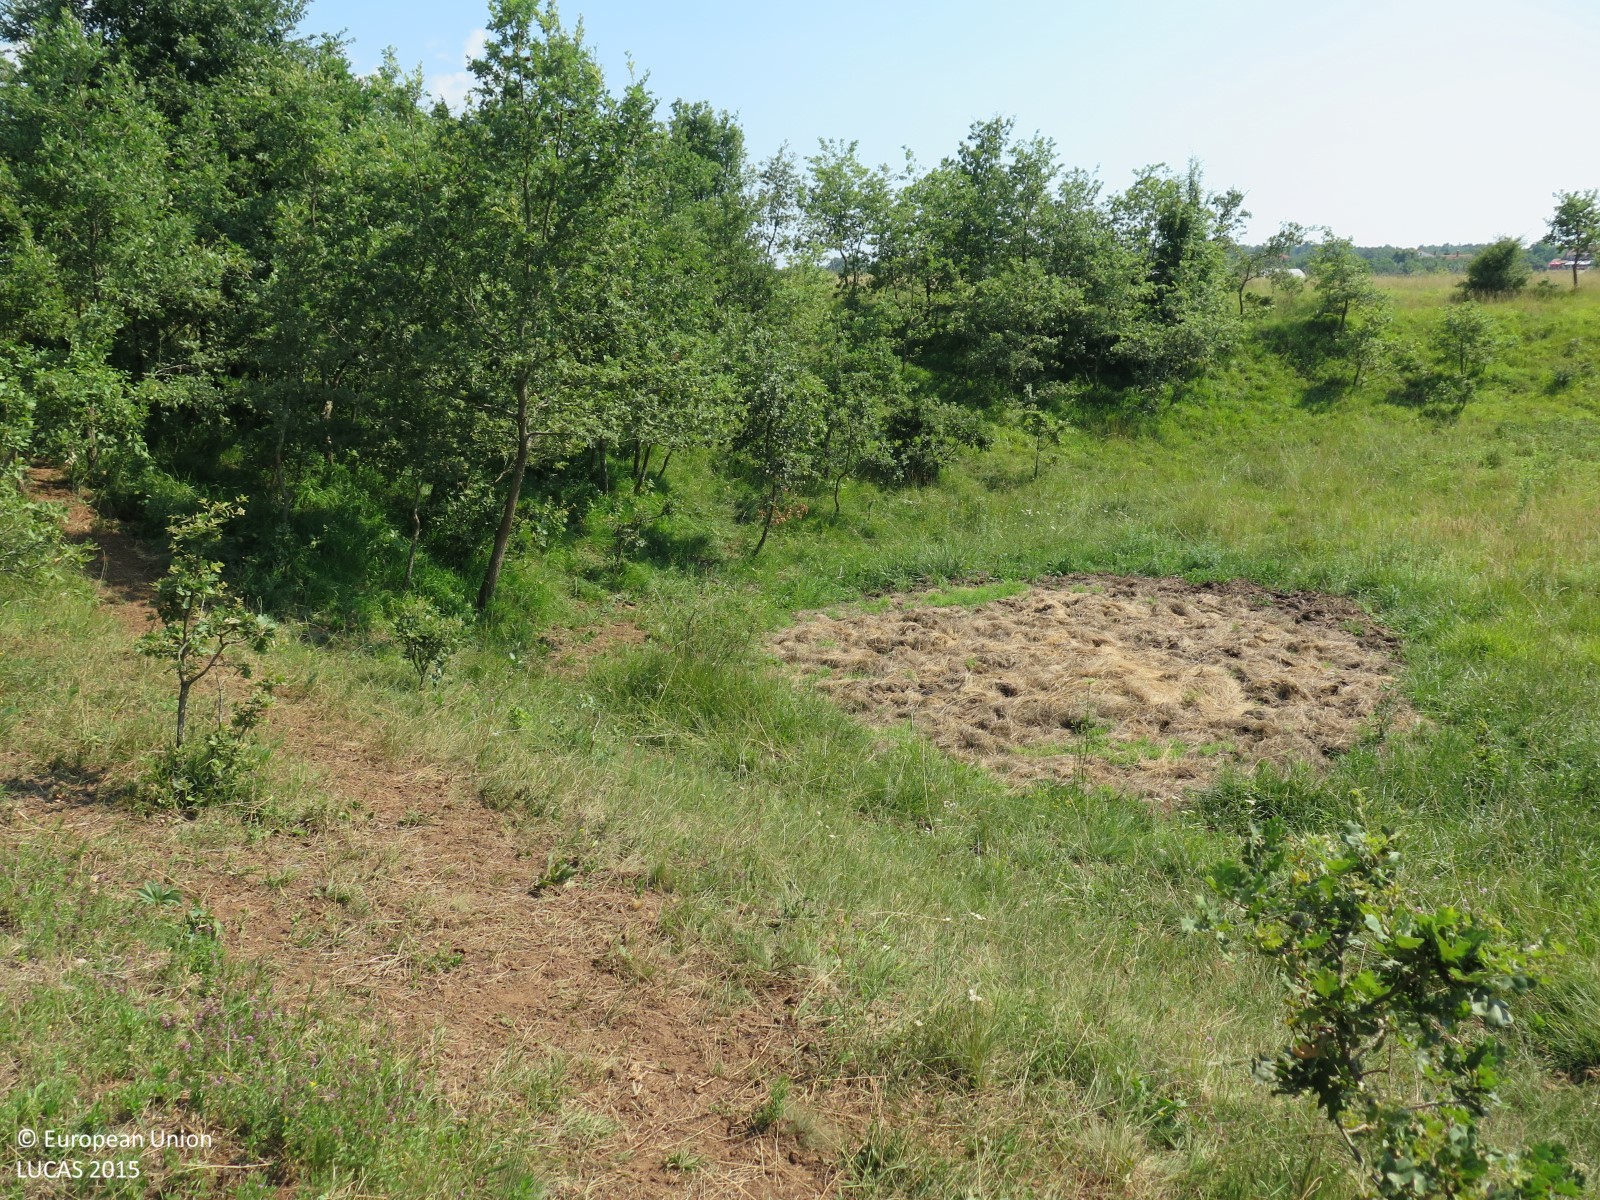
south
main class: Grassland
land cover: Grassland with sparse tree/shrub cover
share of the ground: > 75 %
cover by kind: herbaceous plants 90 %, broadleaved forest trees 5 %, shrubs 5 %
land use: Agriculture (excluding fallow land and kitchen gardens)
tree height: < 5 m
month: July
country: HR
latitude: 45.2185
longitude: 13.8278
